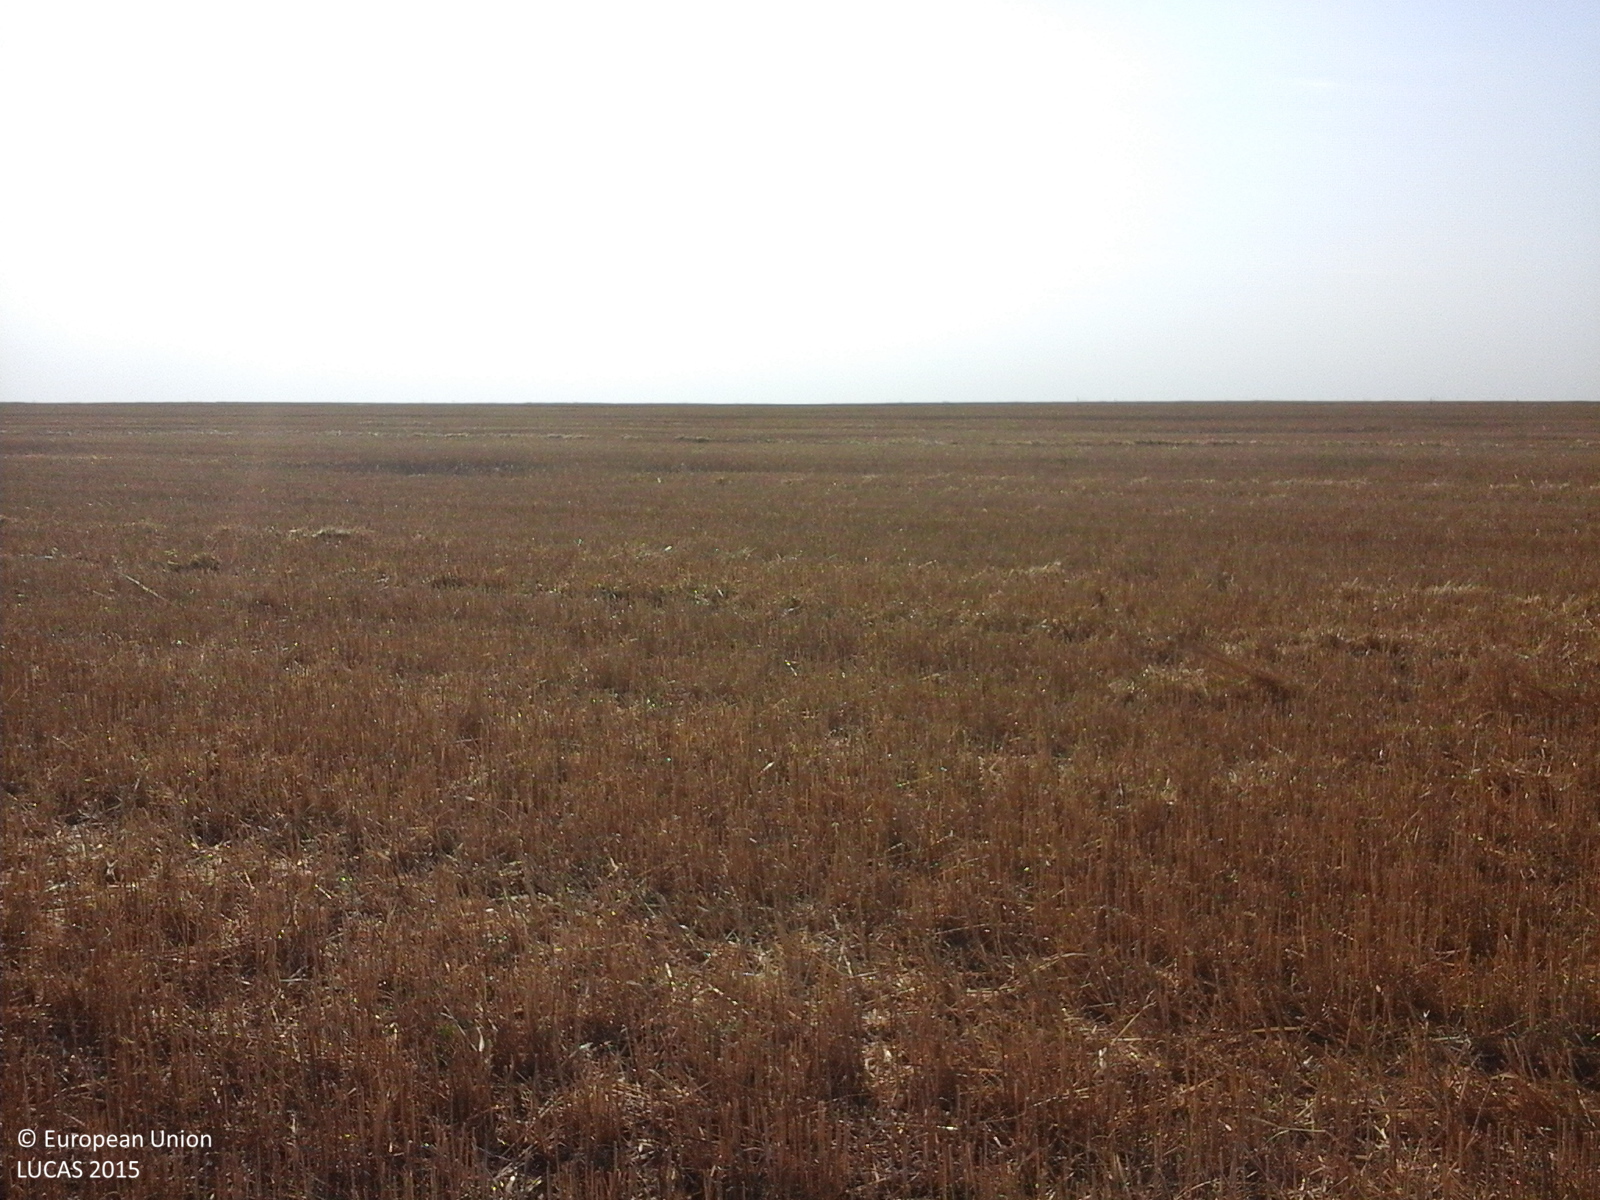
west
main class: Cropland
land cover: Common wheat
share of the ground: > 75 %
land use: Agriculture (excluding fallow land and kitchen gardens)
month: August
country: RO
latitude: 44.0363
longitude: 28.2926
